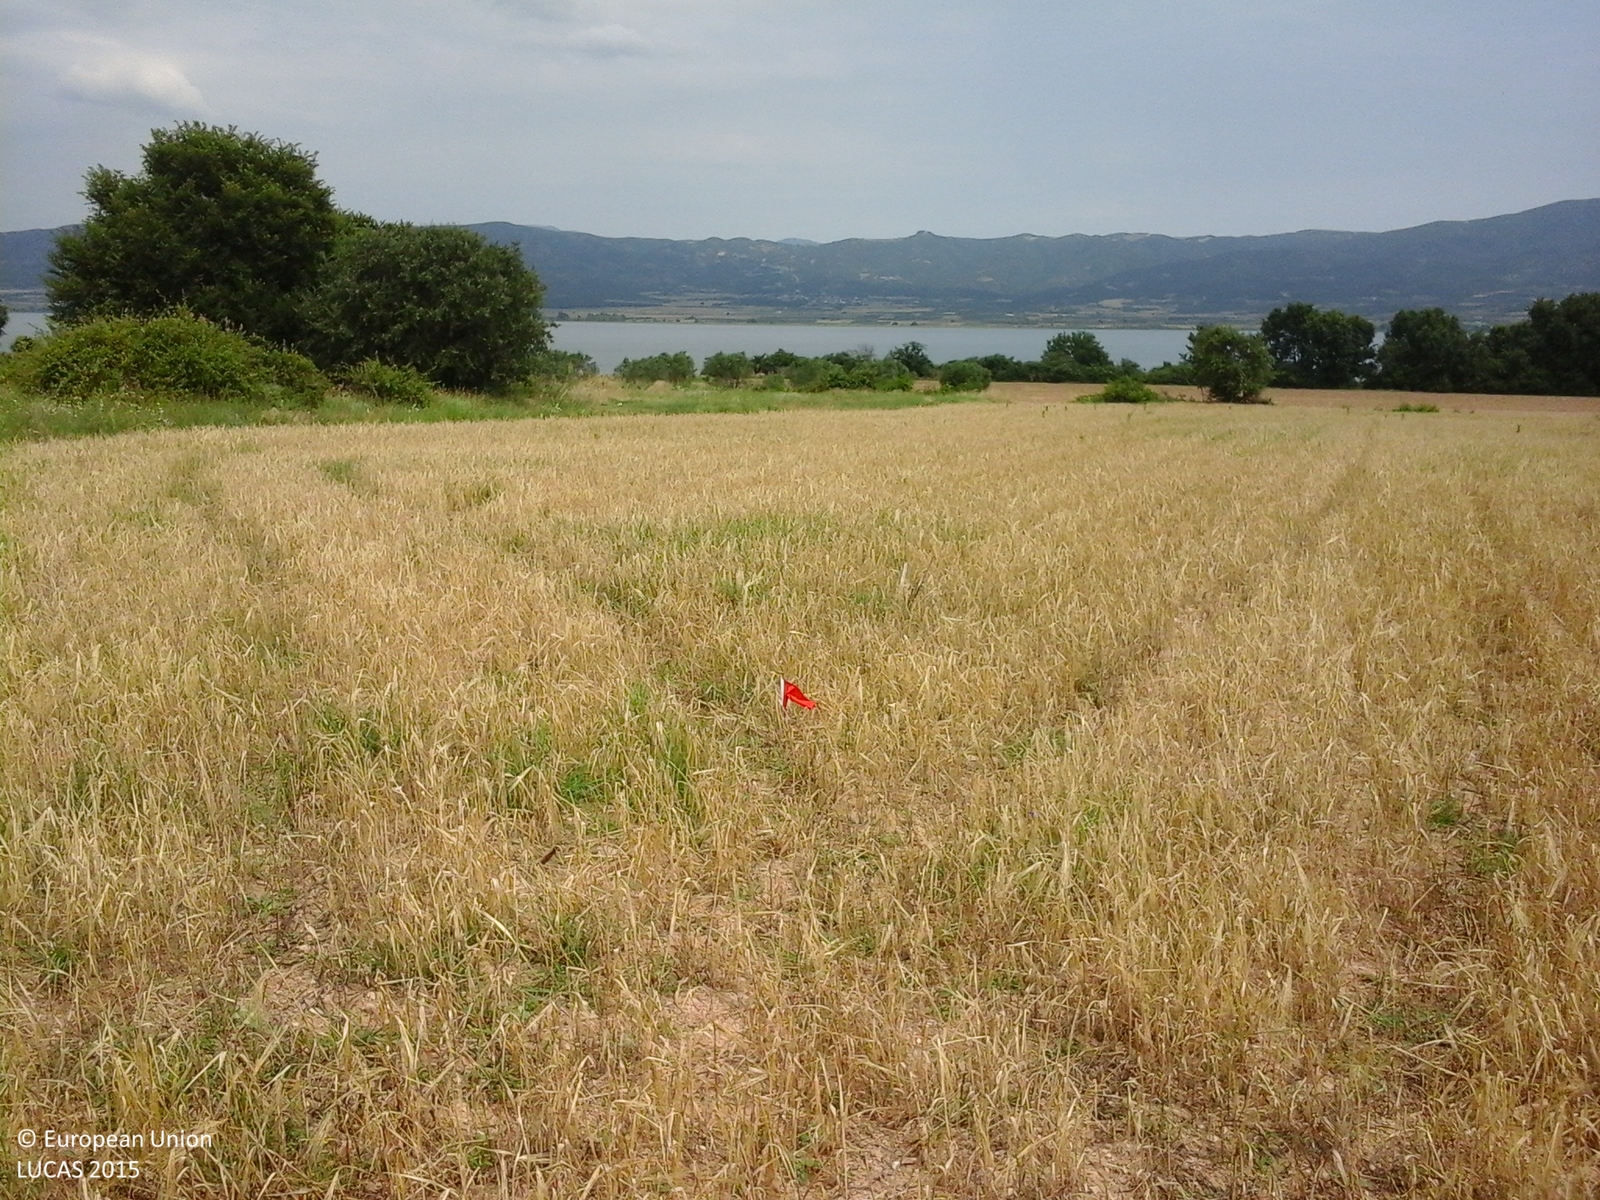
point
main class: Cropland
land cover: Barley
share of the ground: > 75 %
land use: Agriculture (excluding fallow land and kitchen gardens)
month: June
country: GR
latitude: 40.6629
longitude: 23.3909
